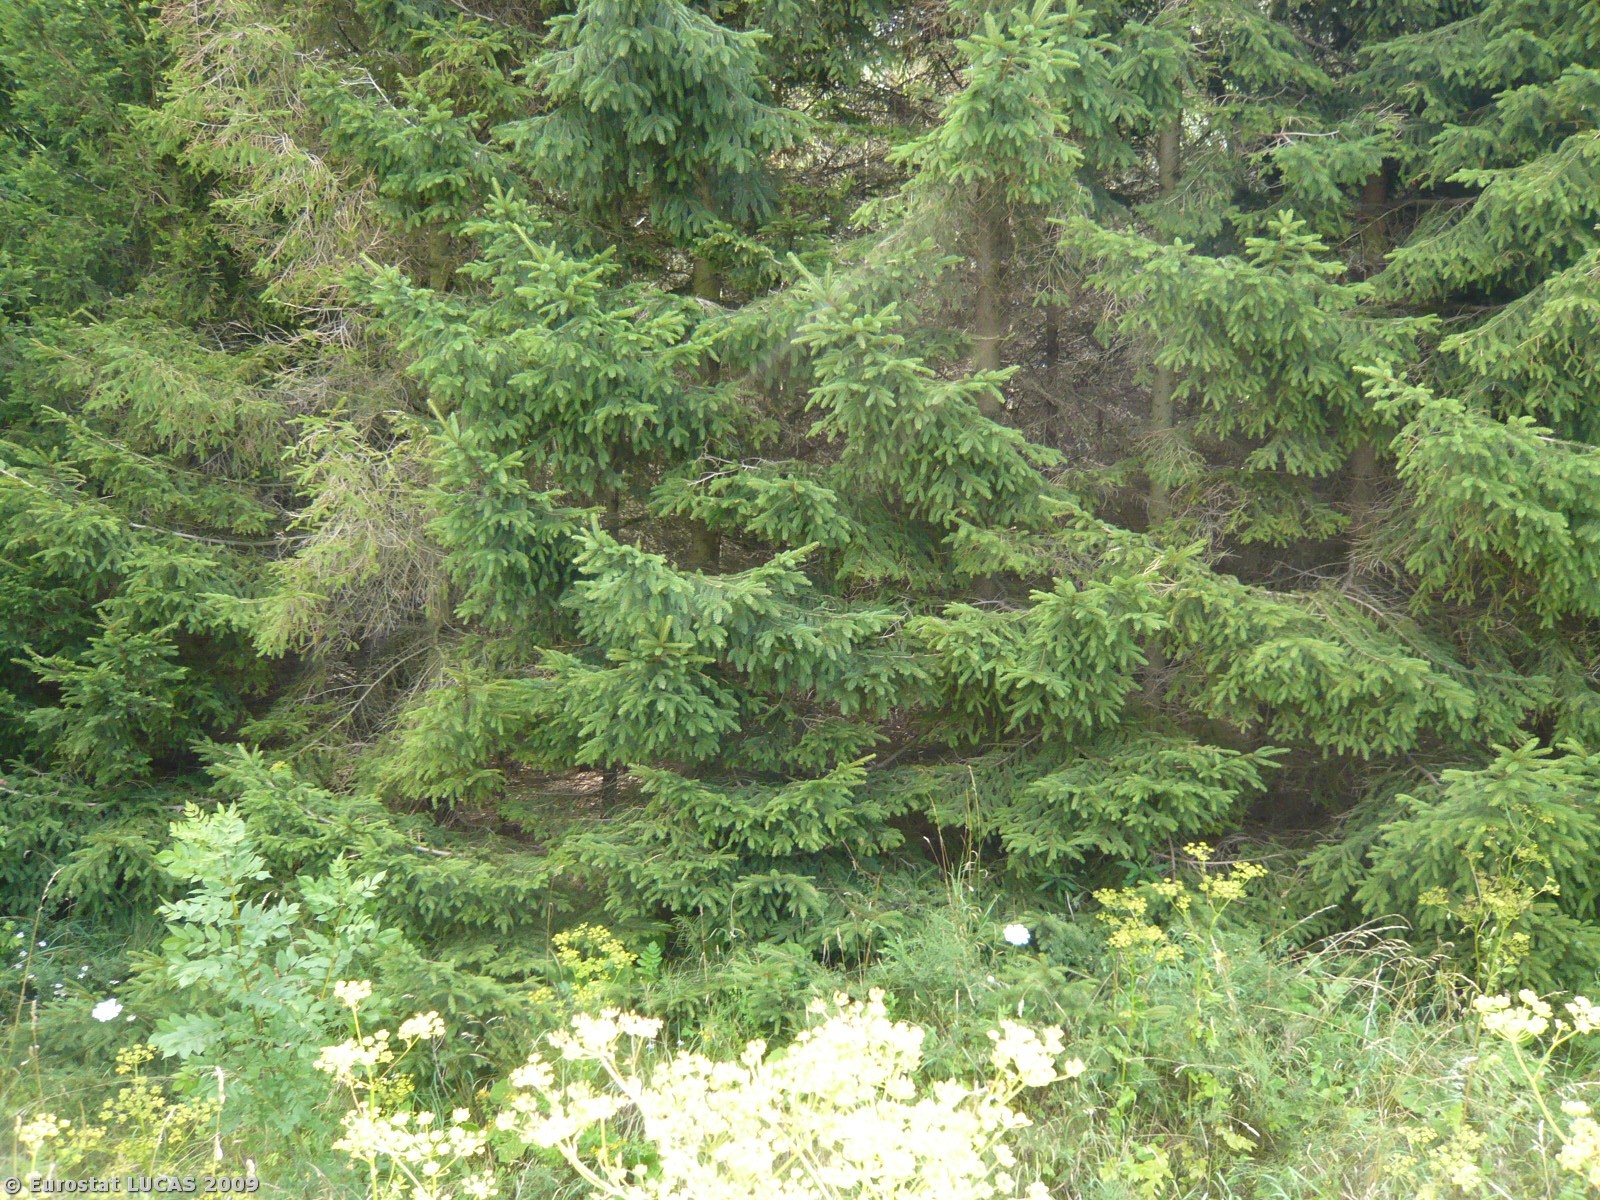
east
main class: Woodland
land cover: Broadleaved woodland
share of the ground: > 75 %
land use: Residential
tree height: > 5 m
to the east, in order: Broadleaved woodland; Artificial constructions in urban areas; Paved roads, cycling and walking lanes; Artificial constructions; Coniferous woodland; Tracks; Broadleaved woodland; Fences; Bare land; Fences; Mixed woodland; Tracks; Mixed woodland; Grassland with sparse tree/shrub cover; Coniferous woodland; Broadleaved woodland; Coniferous woodland; Tracks
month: July
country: DK
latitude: 55.4698
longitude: 12.0706
